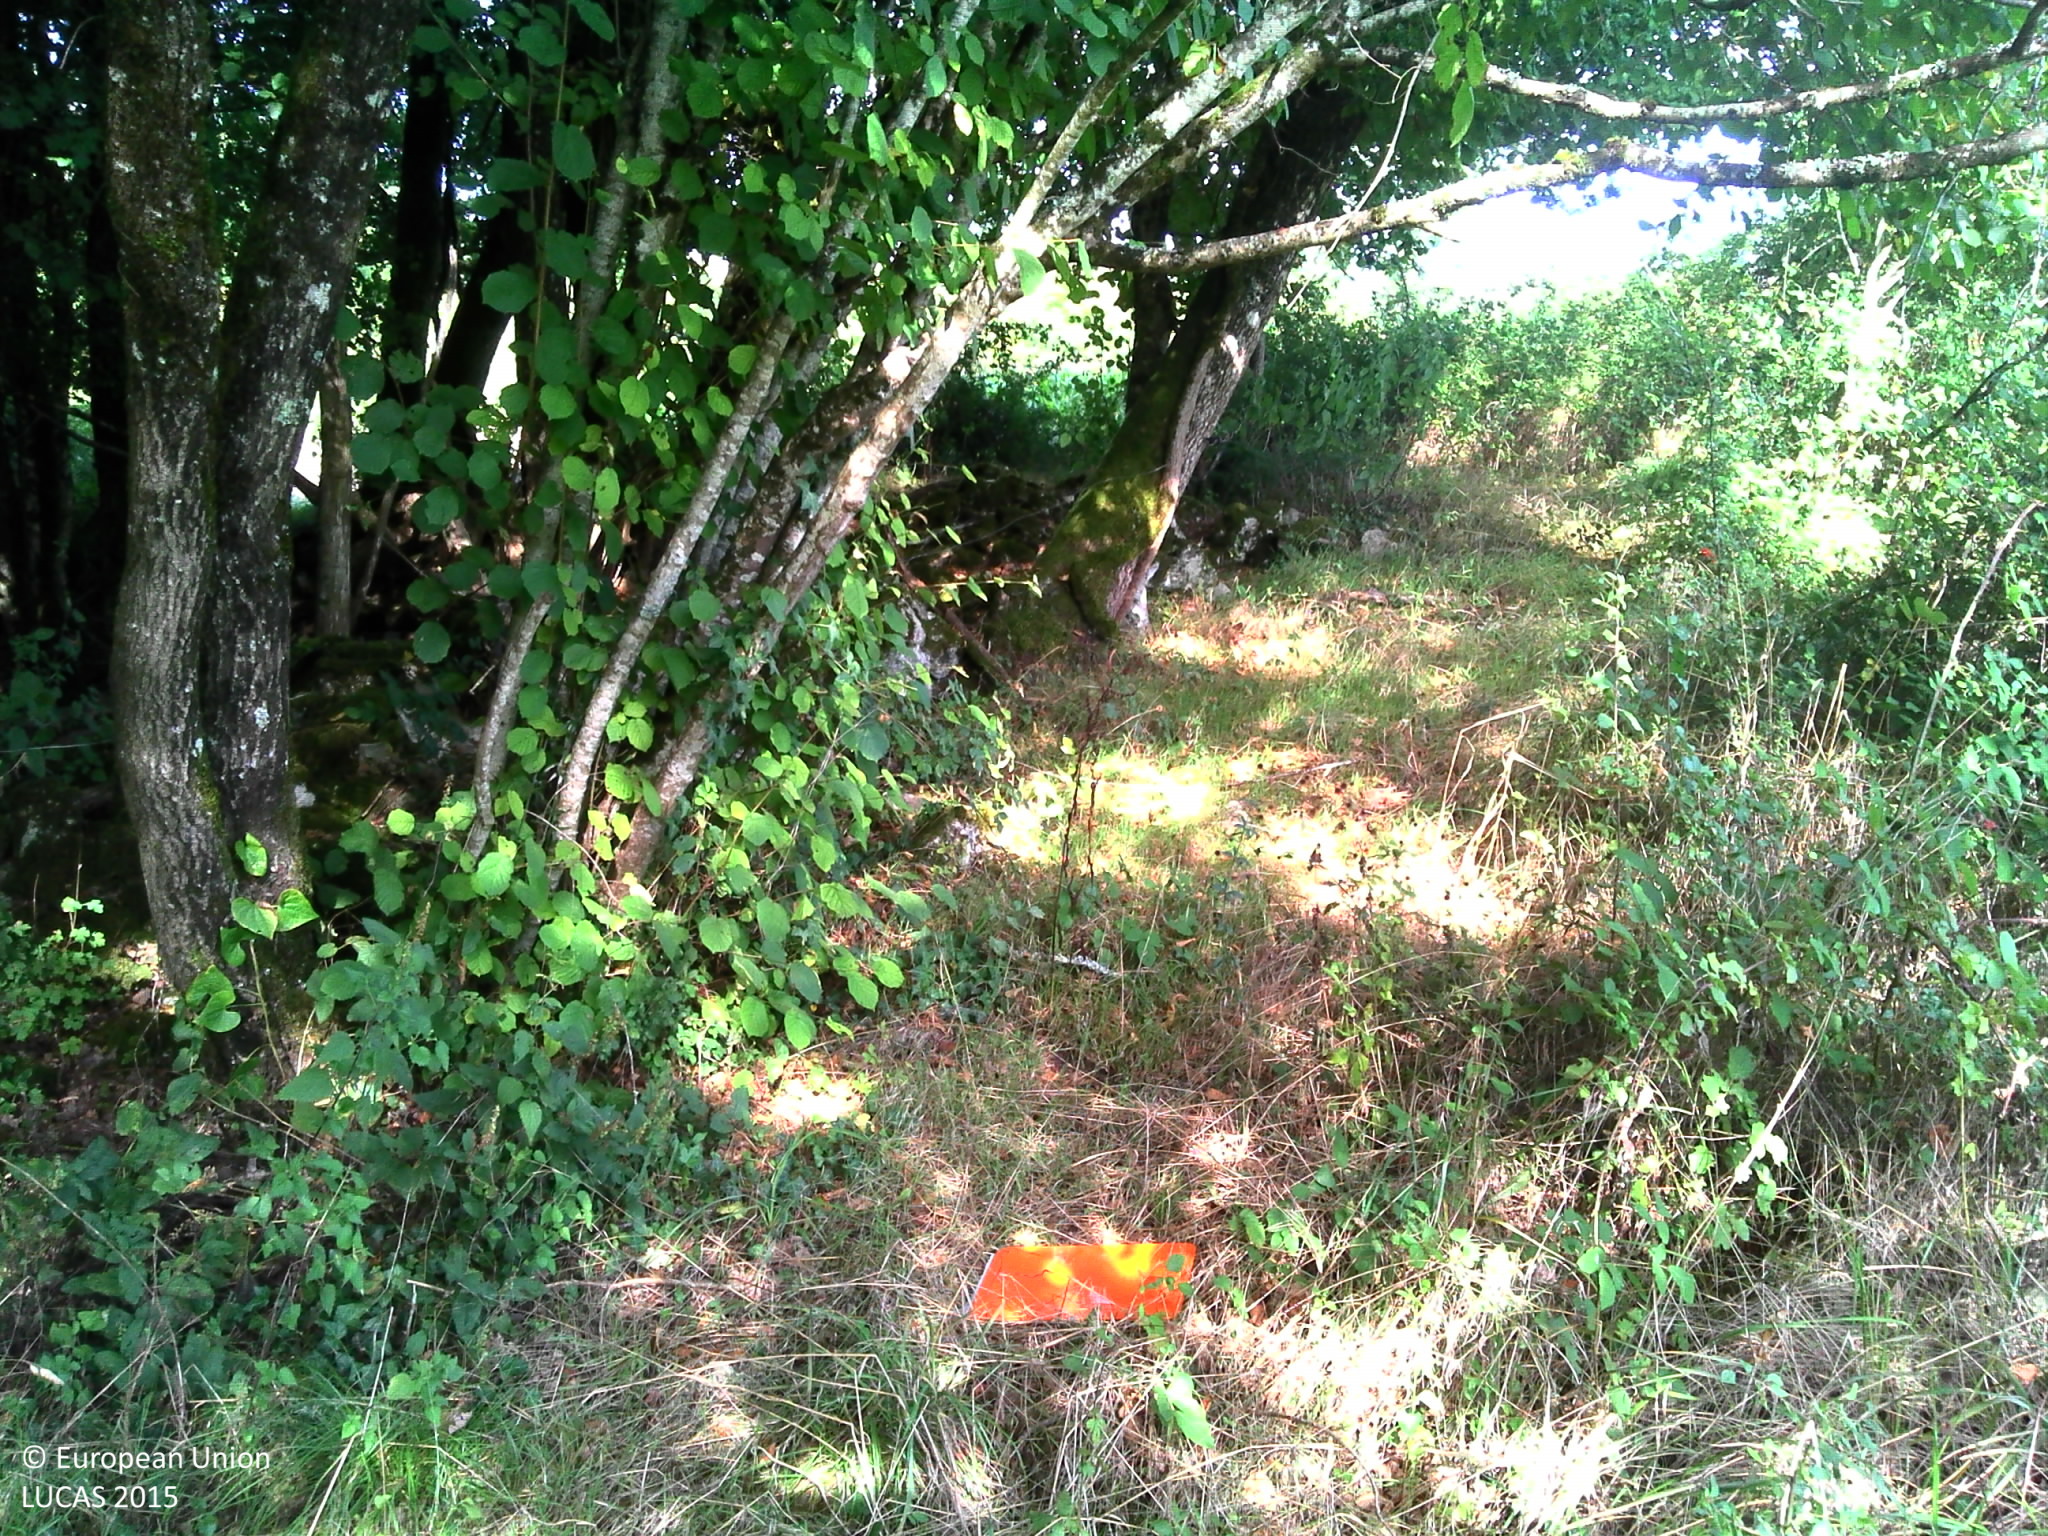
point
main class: Woodland
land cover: Broadleaved woodland
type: mesophytic deciduous forest
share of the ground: > 75 %
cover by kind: broadleaved forest trees 60 %, herbaceous plants 20 %, shrubs 10 %, lichens and mosses 10 %
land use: Forestry
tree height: > 5 m
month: August
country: FR
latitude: 45.4191
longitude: 0.4923
